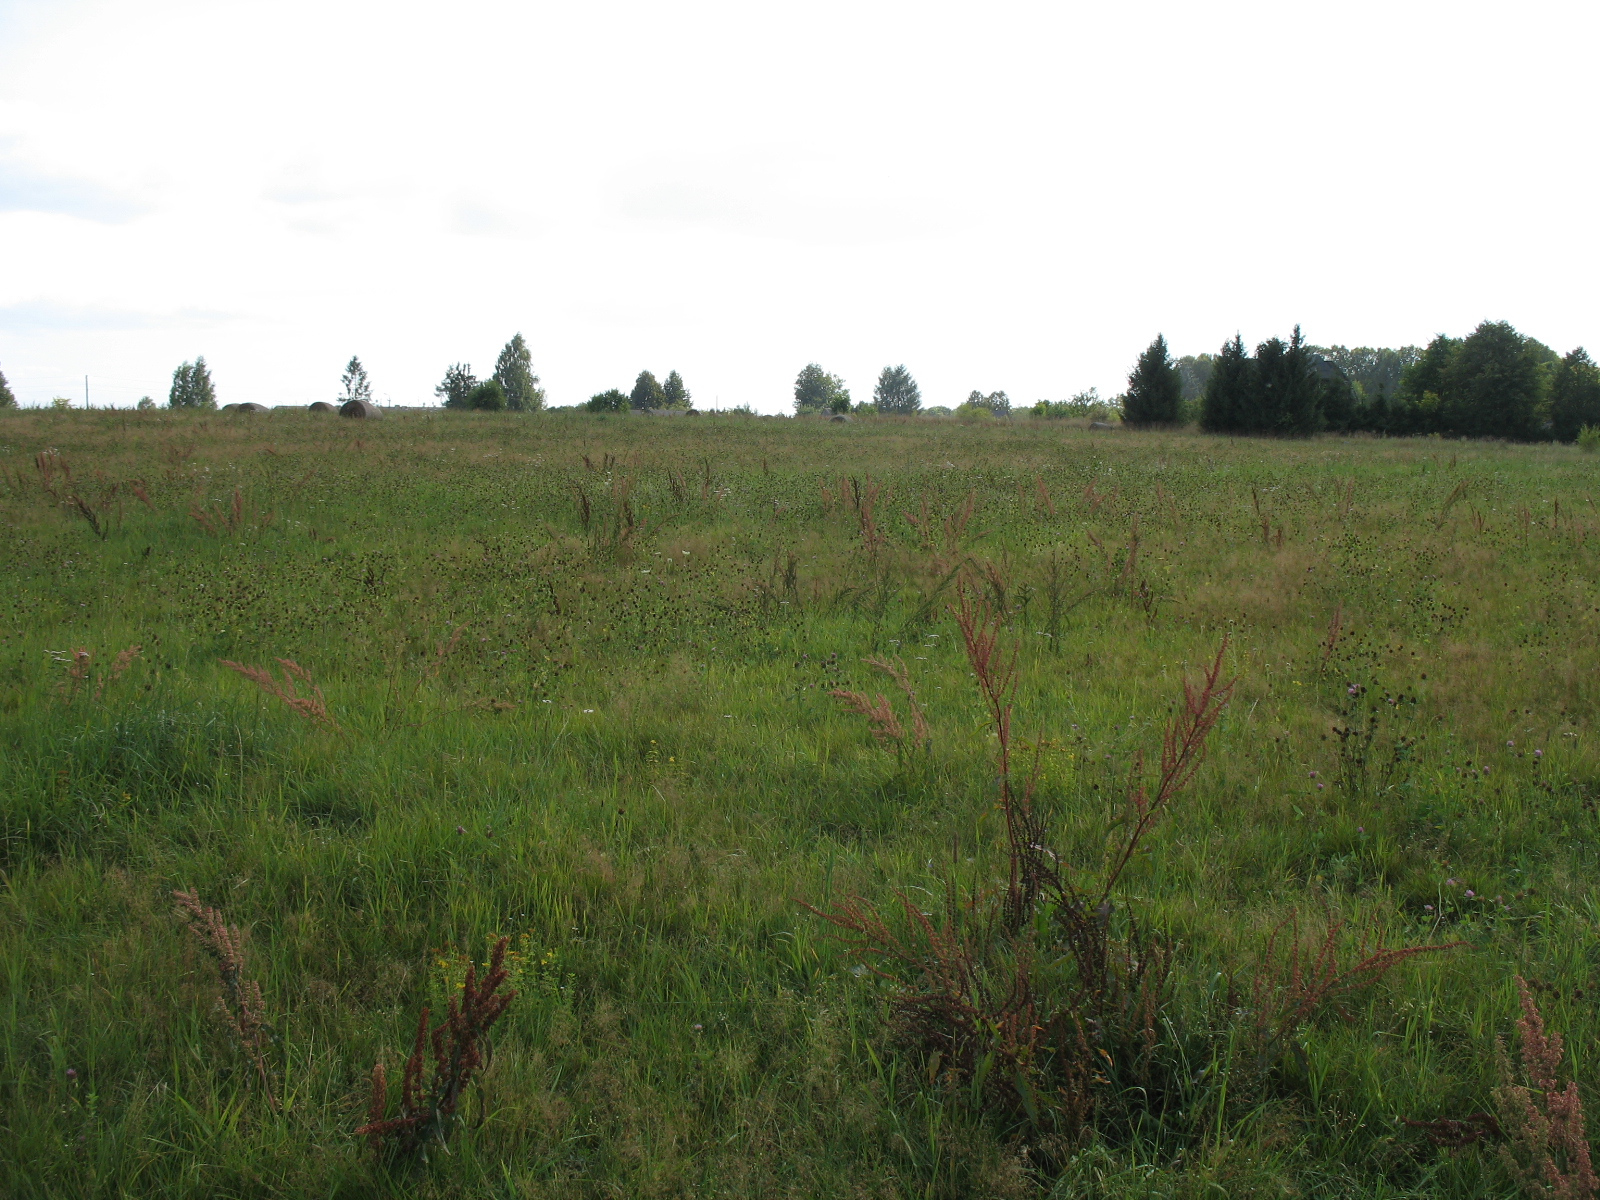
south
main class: Grassland
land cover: Grassland without tree/shrub cover
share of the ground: > 75 %
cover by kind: herbaceous plants 100 %
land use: Agriculture (excluding fallow land and kitchen gardens)
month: August
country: LV
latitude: 56.2968
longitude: 25.9860
